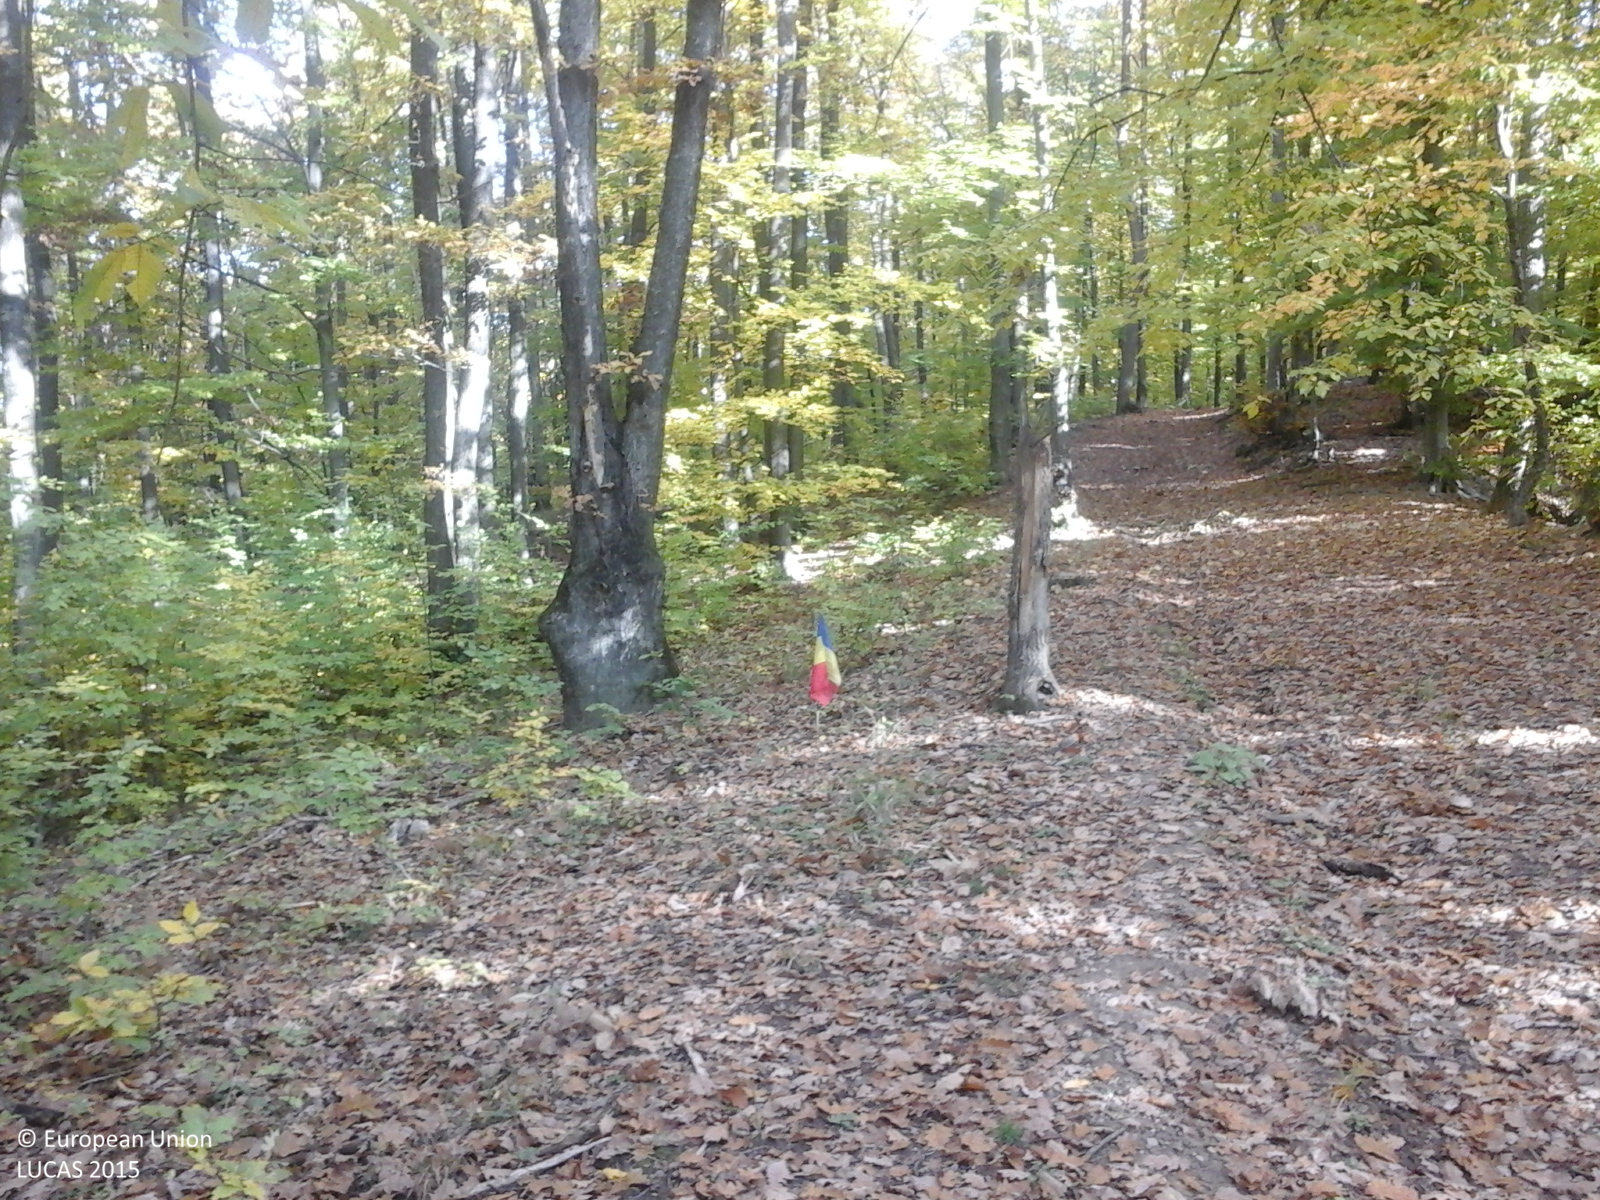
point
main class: Woodland
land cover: Broadleaved woodland
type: beech forest
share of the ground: > 75 %
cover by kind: broadleaved forest trees 100 %
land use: Forestry
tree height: > 5 m
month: October
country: RO
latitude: 46.0027
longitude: 26.9154
